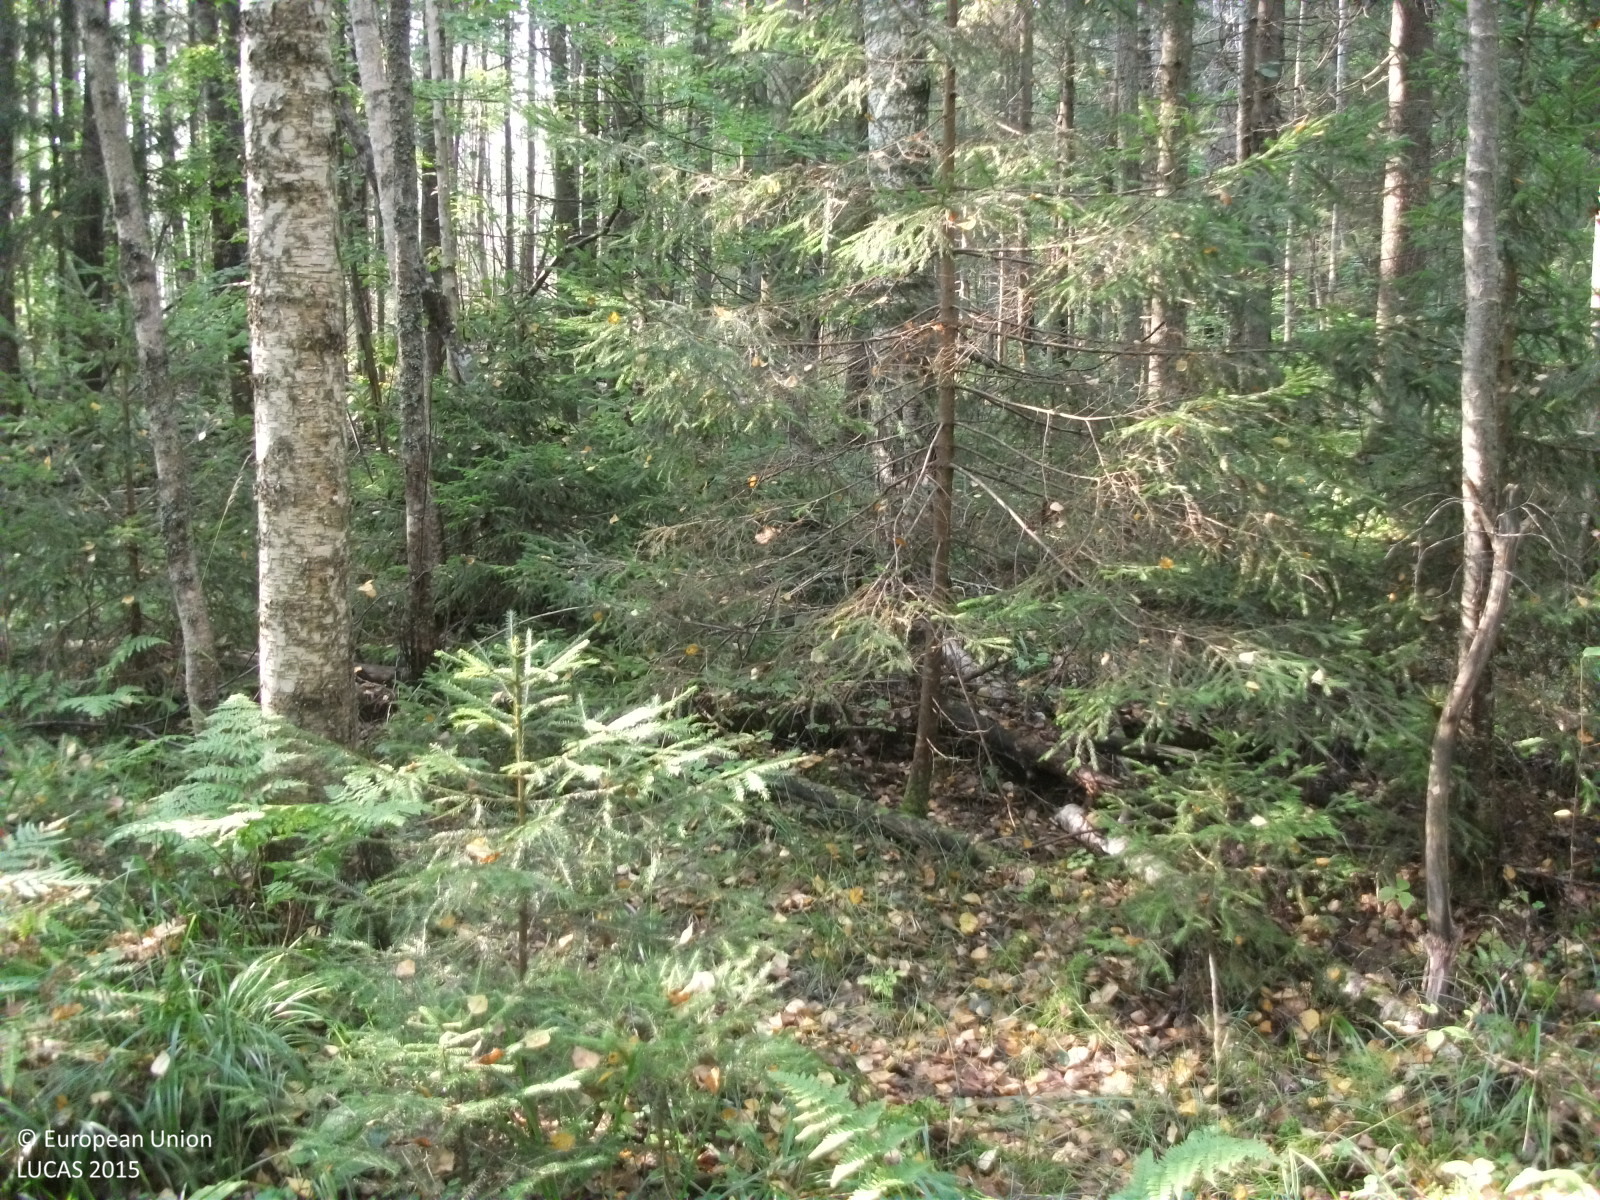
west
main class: Woodland
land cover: Spruce dominated mixed woodland
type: hemiboreal forest and nemoral coniferous forest and mixed broadleaved-coniferous forest
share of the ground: > 75 %
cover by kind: coniferous forest trees 50 %, broadleaved forest trees 30 %, herbaceous plants 10 %, shrubs 5 %, unconsolidated bare surface 5 %
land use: Forestry
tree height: > 5 m
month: September
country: LV
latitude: 57.8105
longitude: 24.5132
